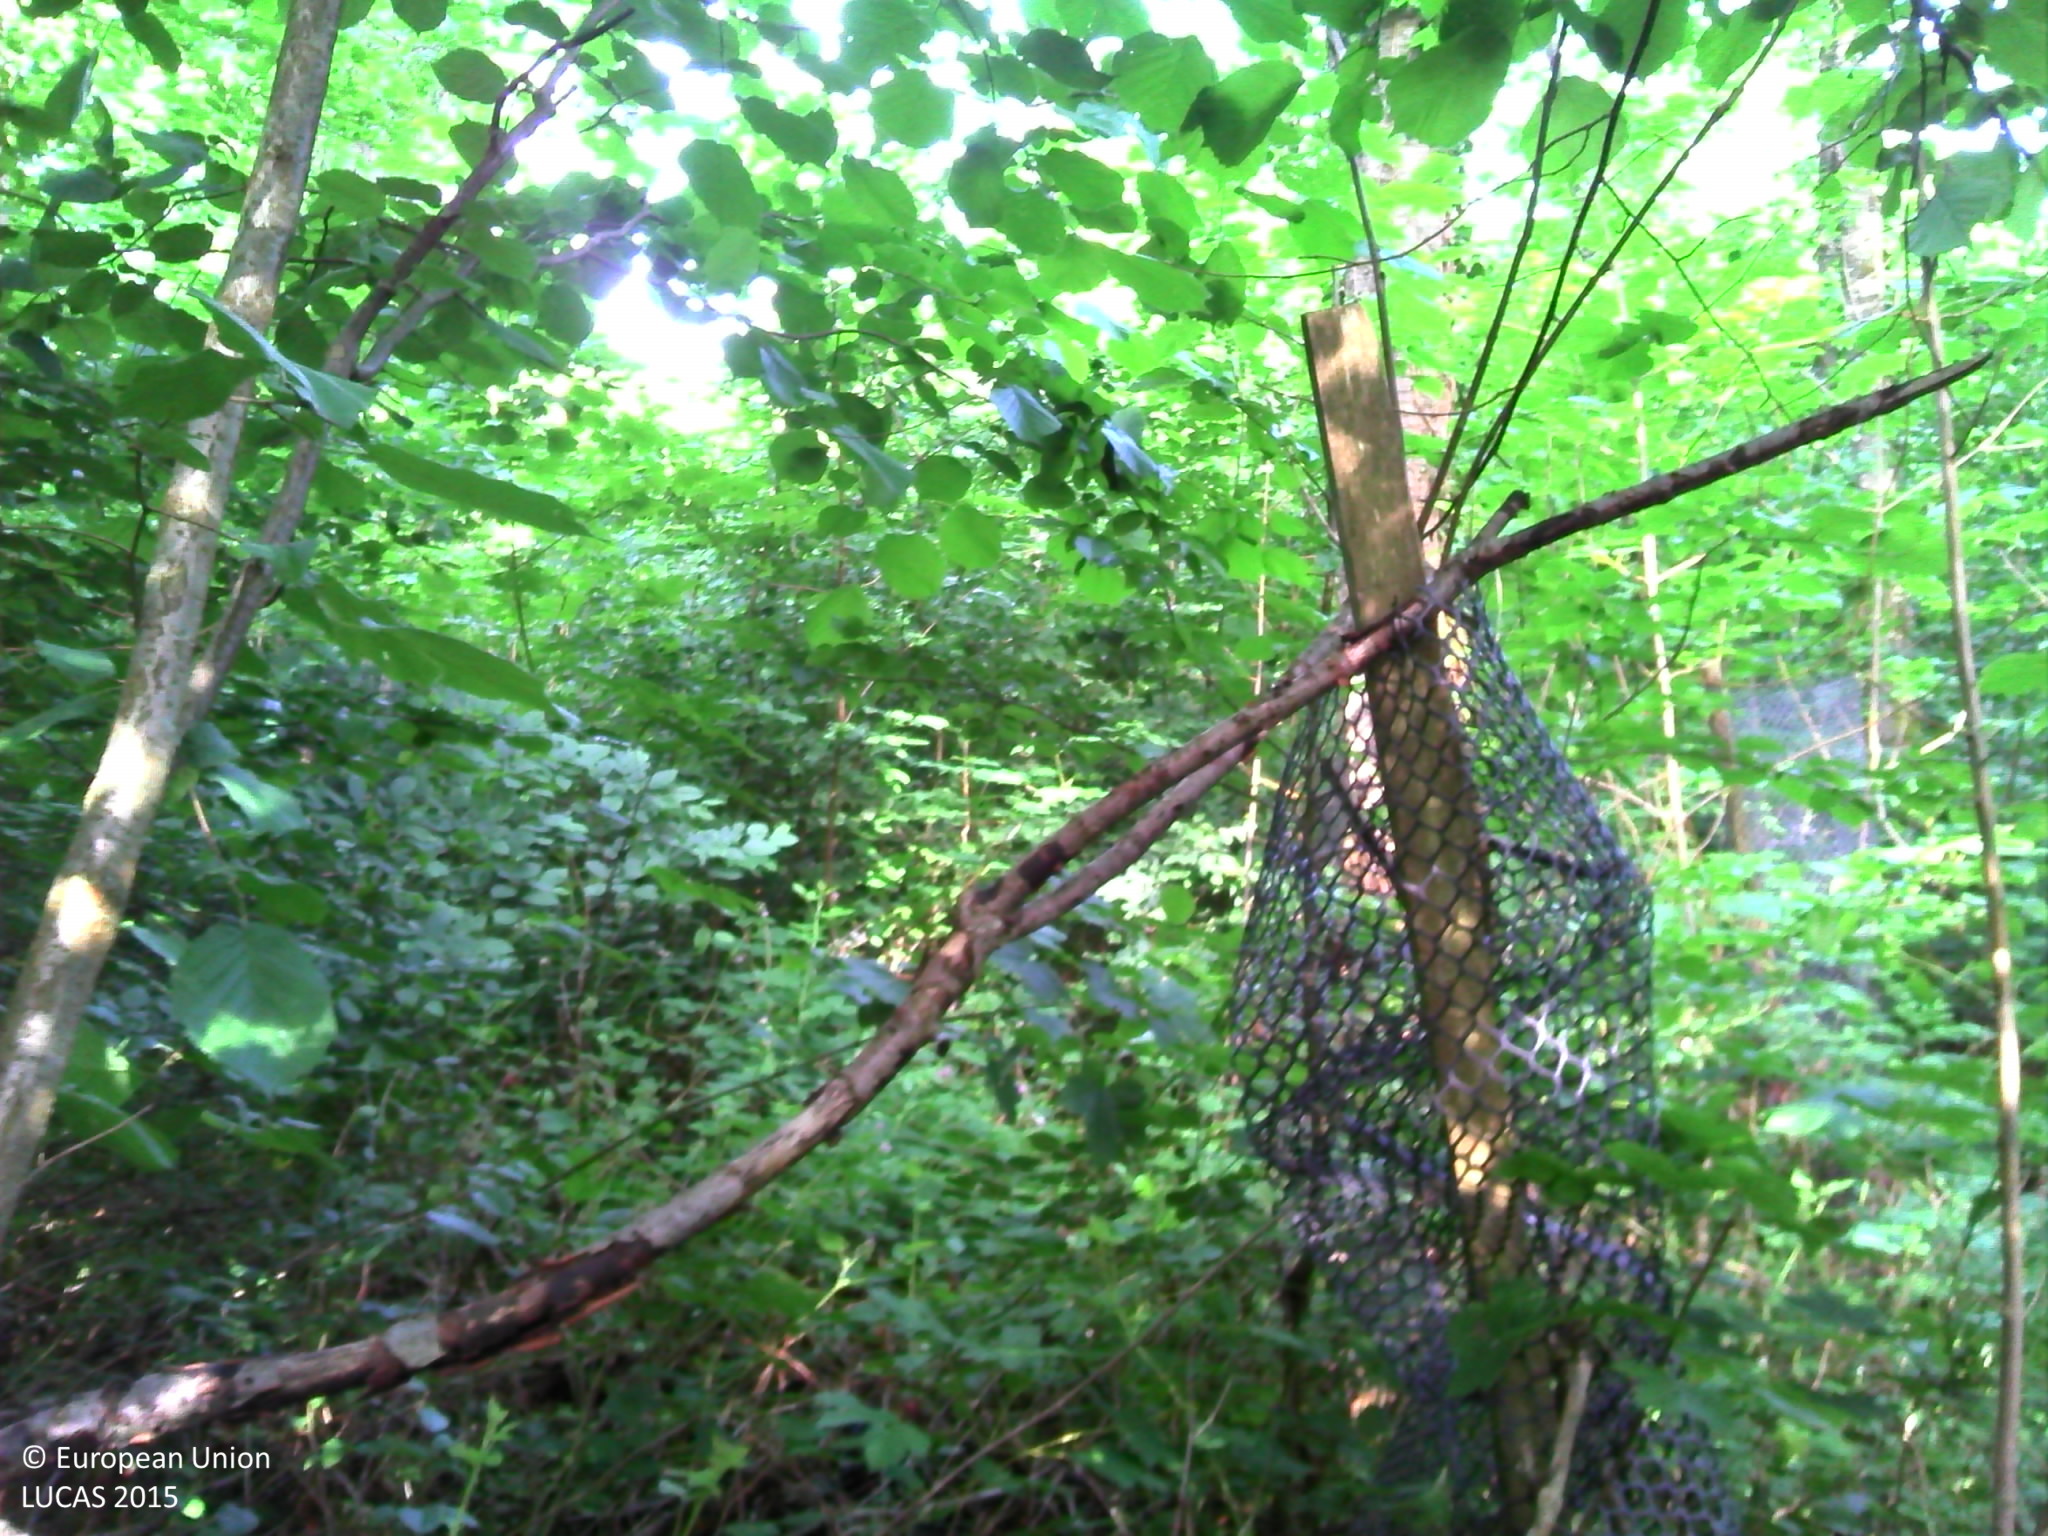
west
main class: Woodland
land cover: Broadleaved woodland
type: mesophytic deciduous forest
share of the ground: > 75 %
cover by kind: broadleaved forest trees 100 %
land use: Forestry
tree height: > 5 m
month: June
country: BE
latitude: 50.1037
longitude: 5.2582
